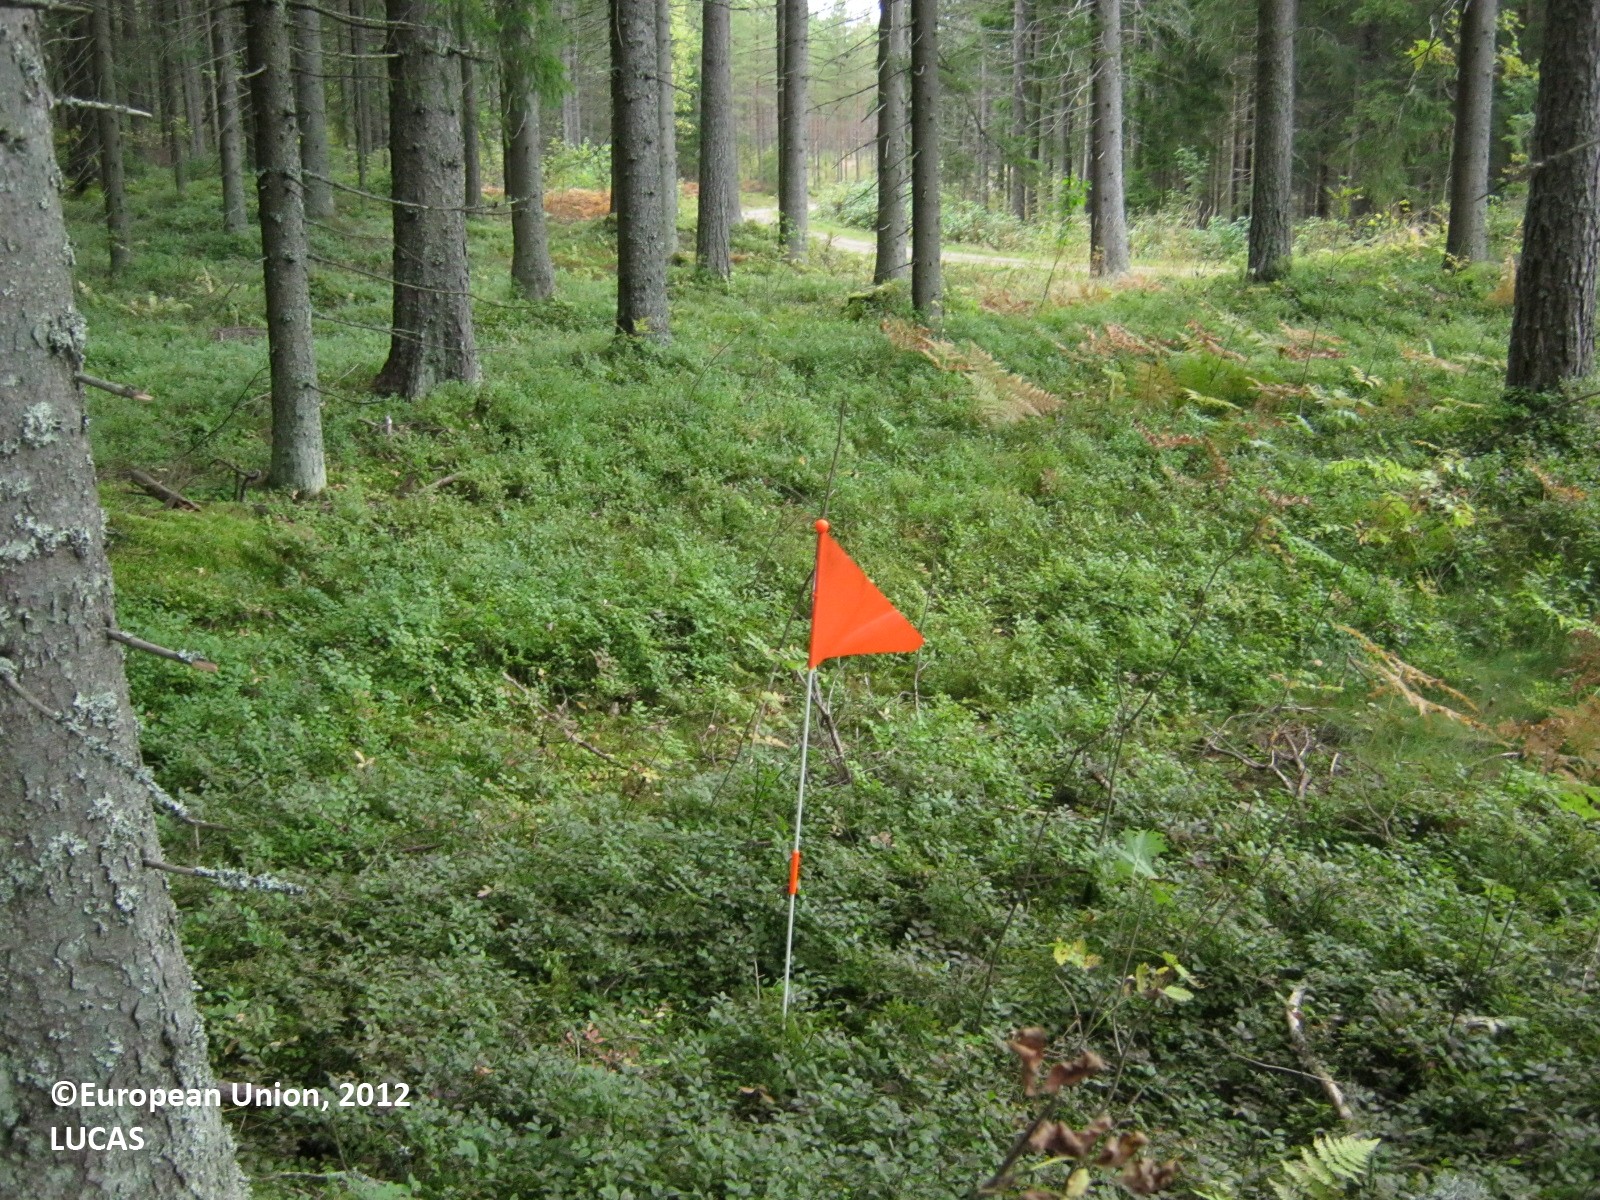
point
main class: Woodland
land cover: Spruce dominated coniferous woodland
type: boreal forest
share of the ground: > 75 %
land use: Forestry
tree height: > 5 m
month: September
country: FI
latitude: 60.7712
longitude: 27.8385
